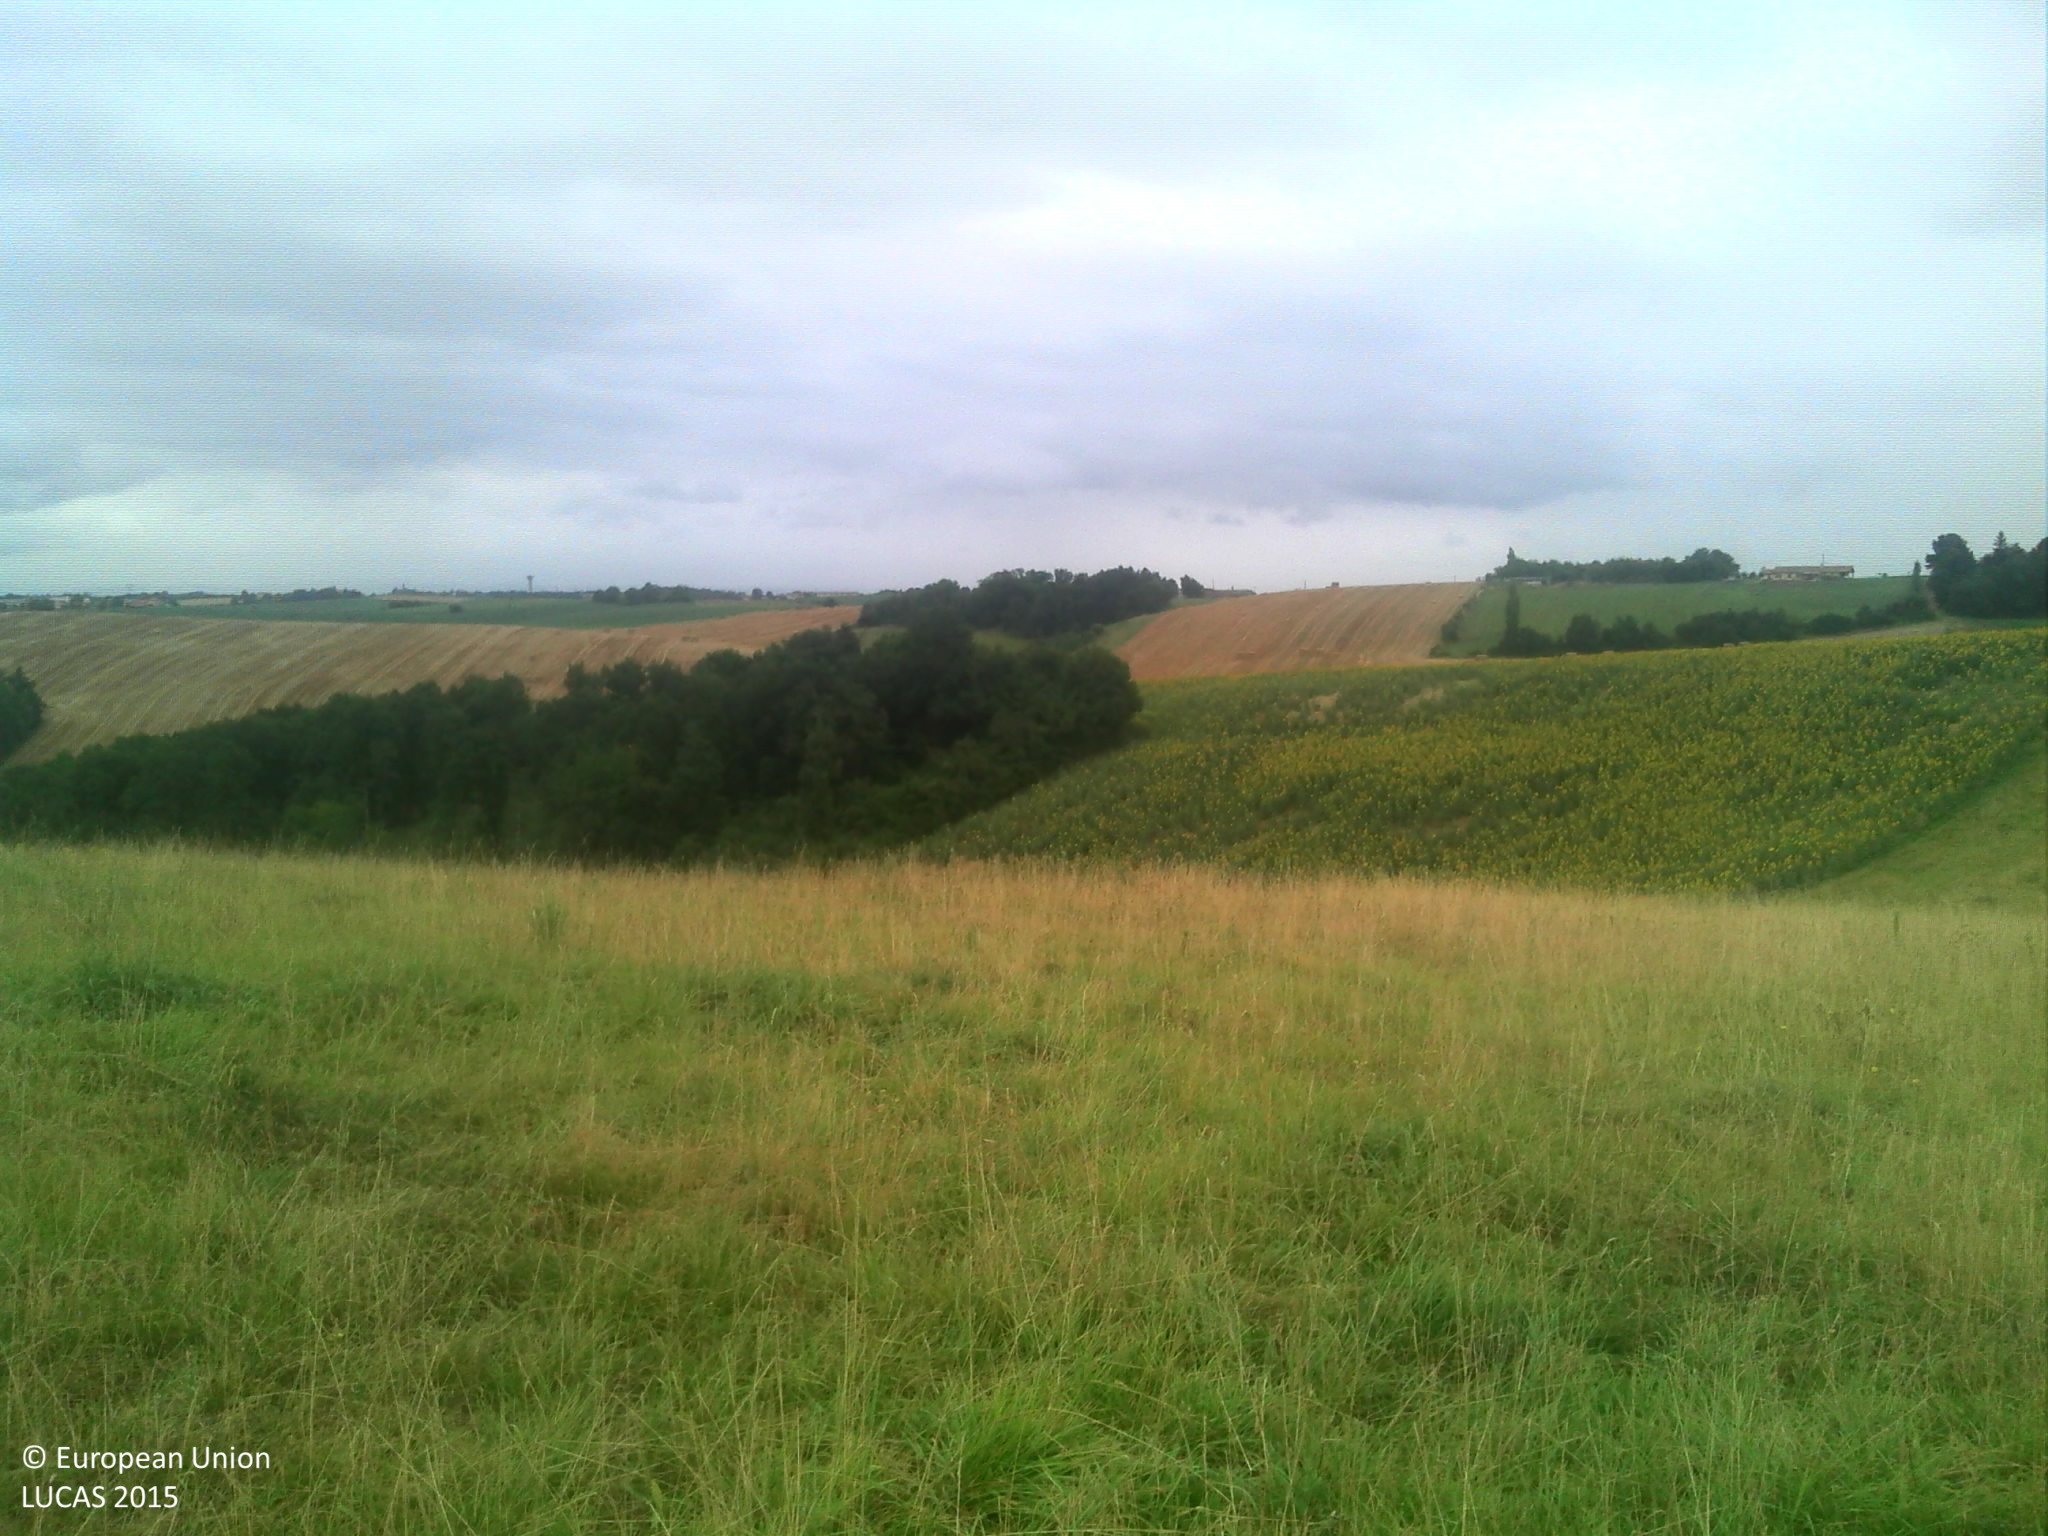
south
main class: Cropland
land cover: Temporary grasslands
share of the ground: > 75 %
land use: Agriculture (excluding fallow land and kitchen gardens)
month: July
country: FR
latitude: 43.2690
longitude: 1.4169
